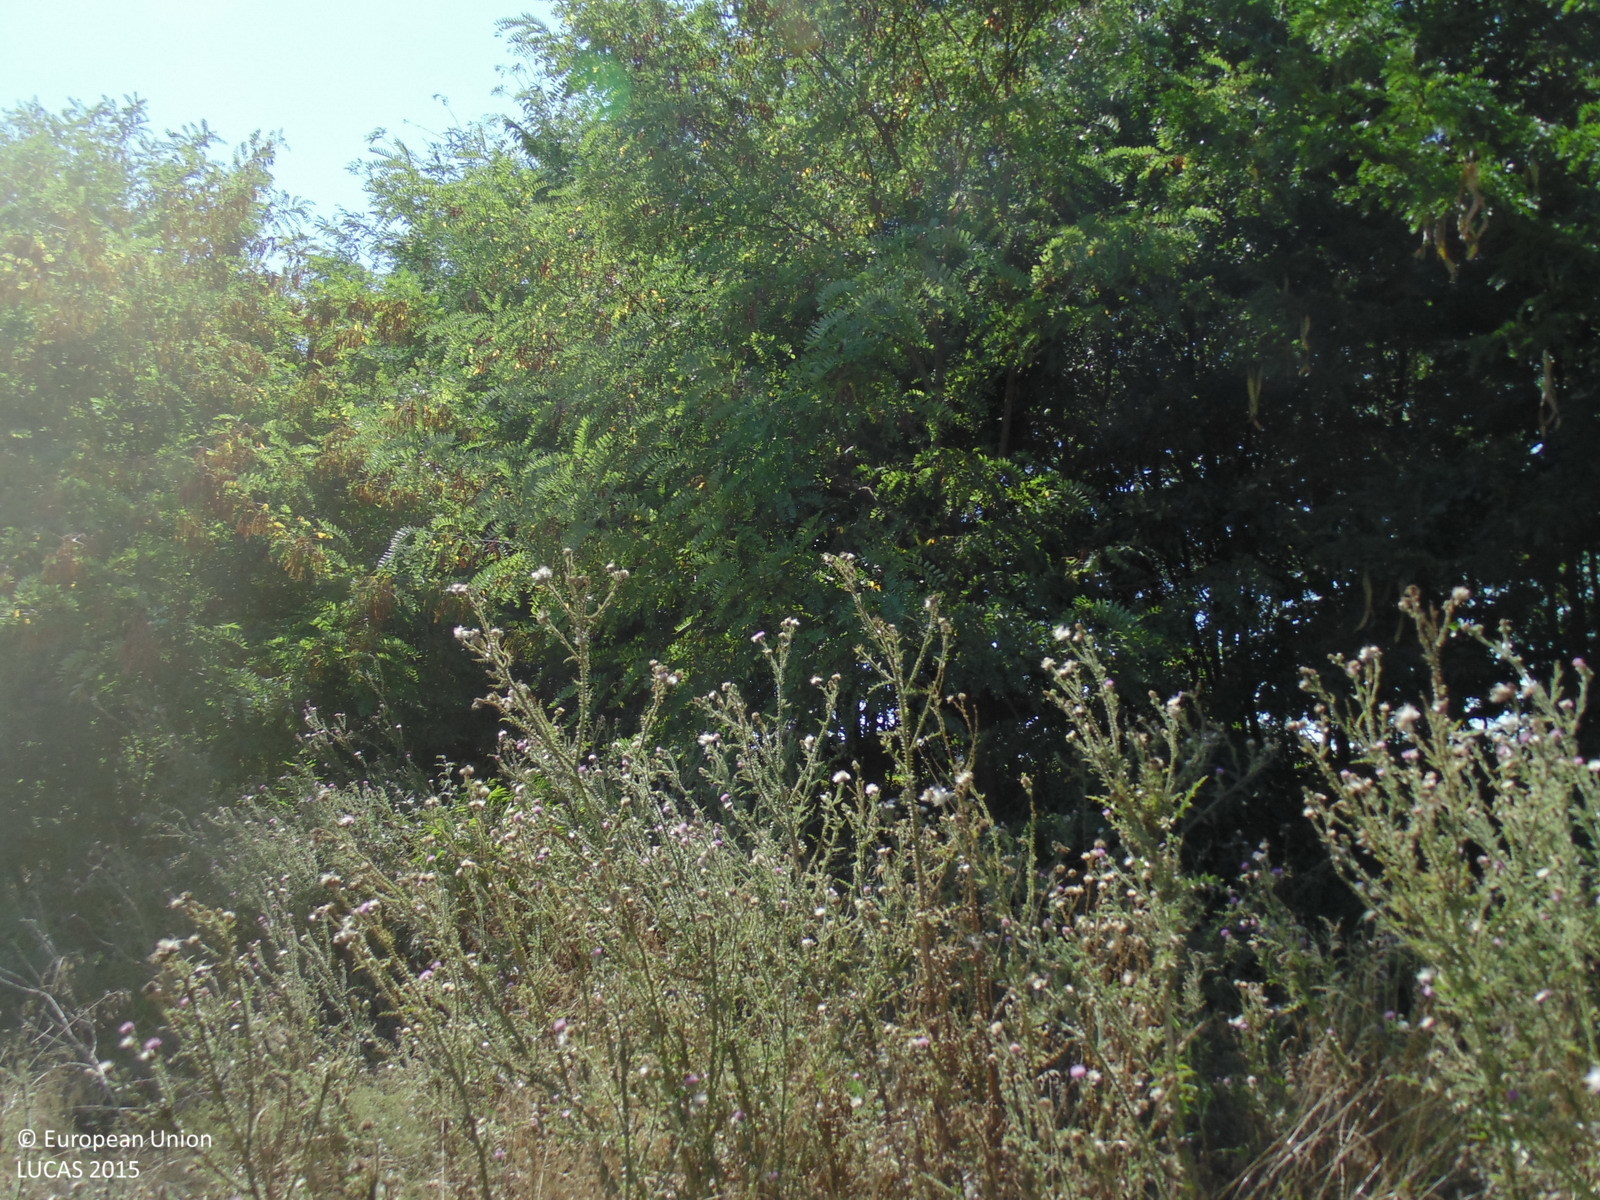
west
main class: Woodland
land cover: Broadleaved woodland
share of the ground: > 75 %
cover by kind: broadleaved forest trees 90 %, herbaceous plants 10 %
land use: Forestry
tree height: > 5 m
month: August
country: BG
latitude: 43.5089
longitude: 28.2495
